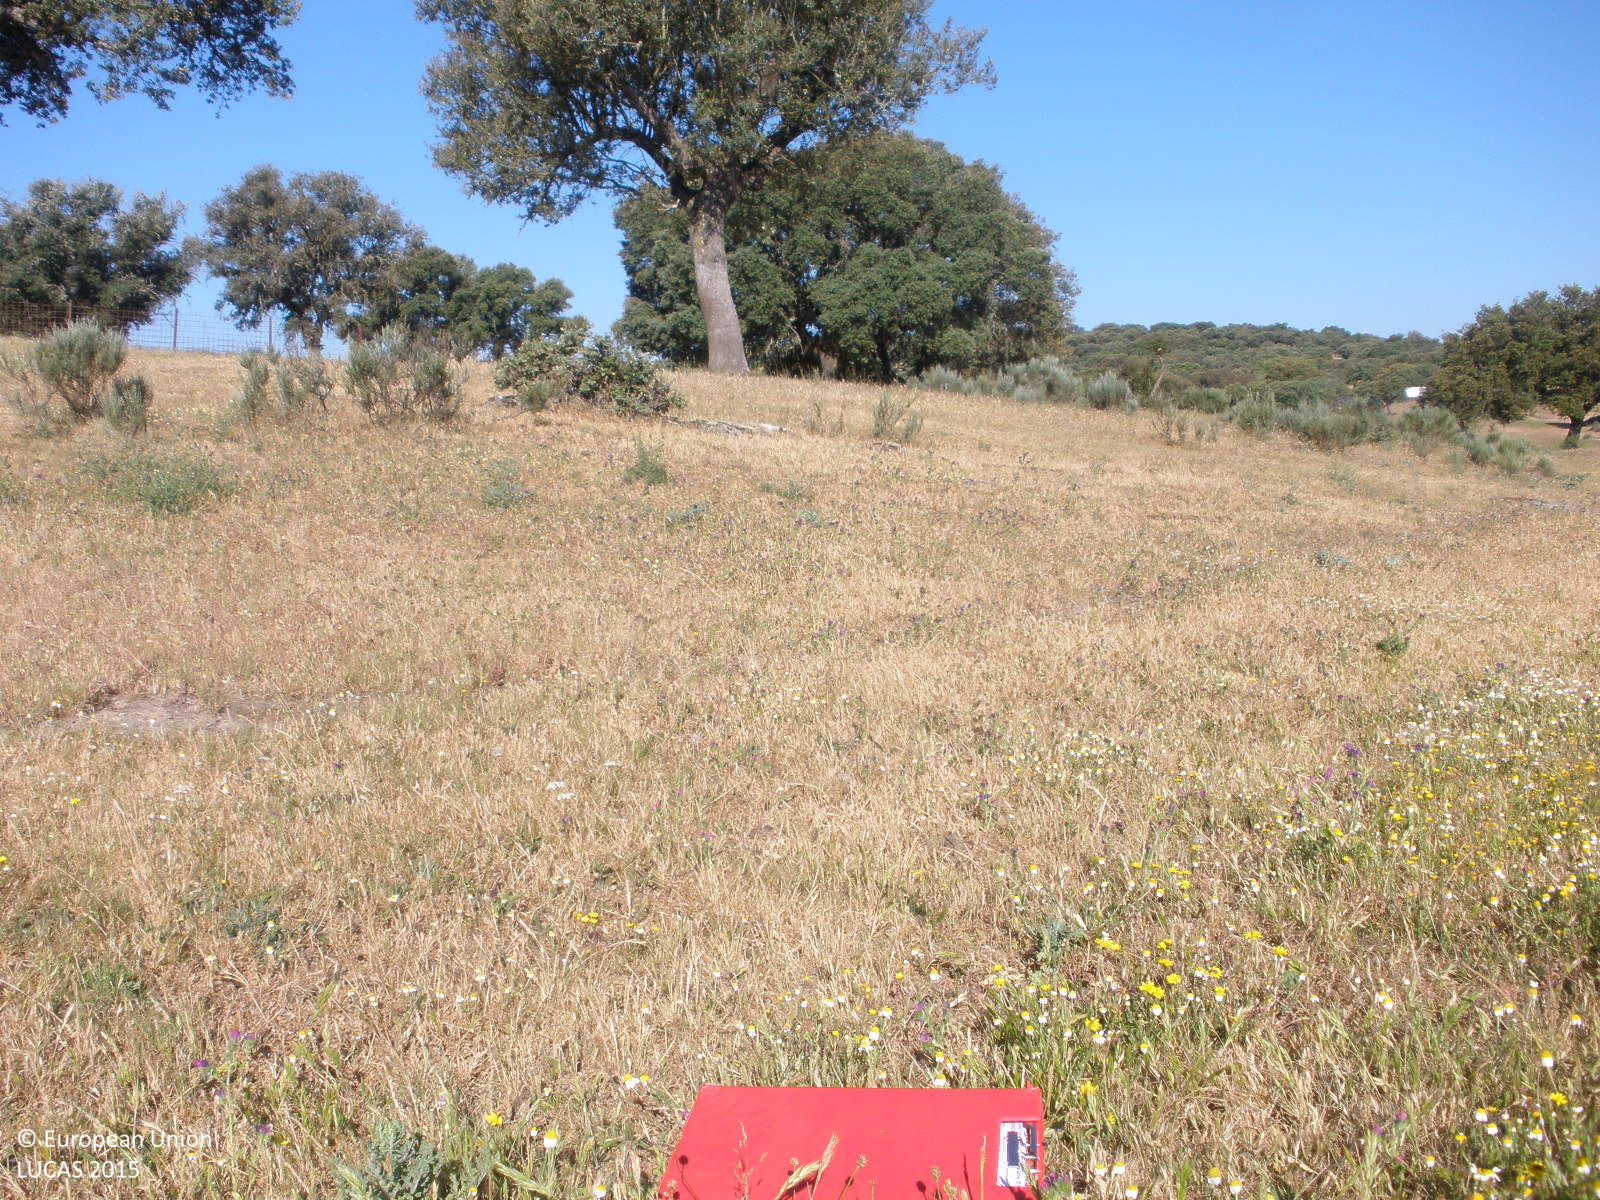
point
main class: Grassland
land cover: Grassland without tree/shrub cover
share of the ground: > 75 %
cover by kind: herbaceous plants 100 %
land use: Agriculture (excluding fallow land and kitchen gardens)
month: June
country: ES
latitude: 40.4572
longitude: -6.6344
